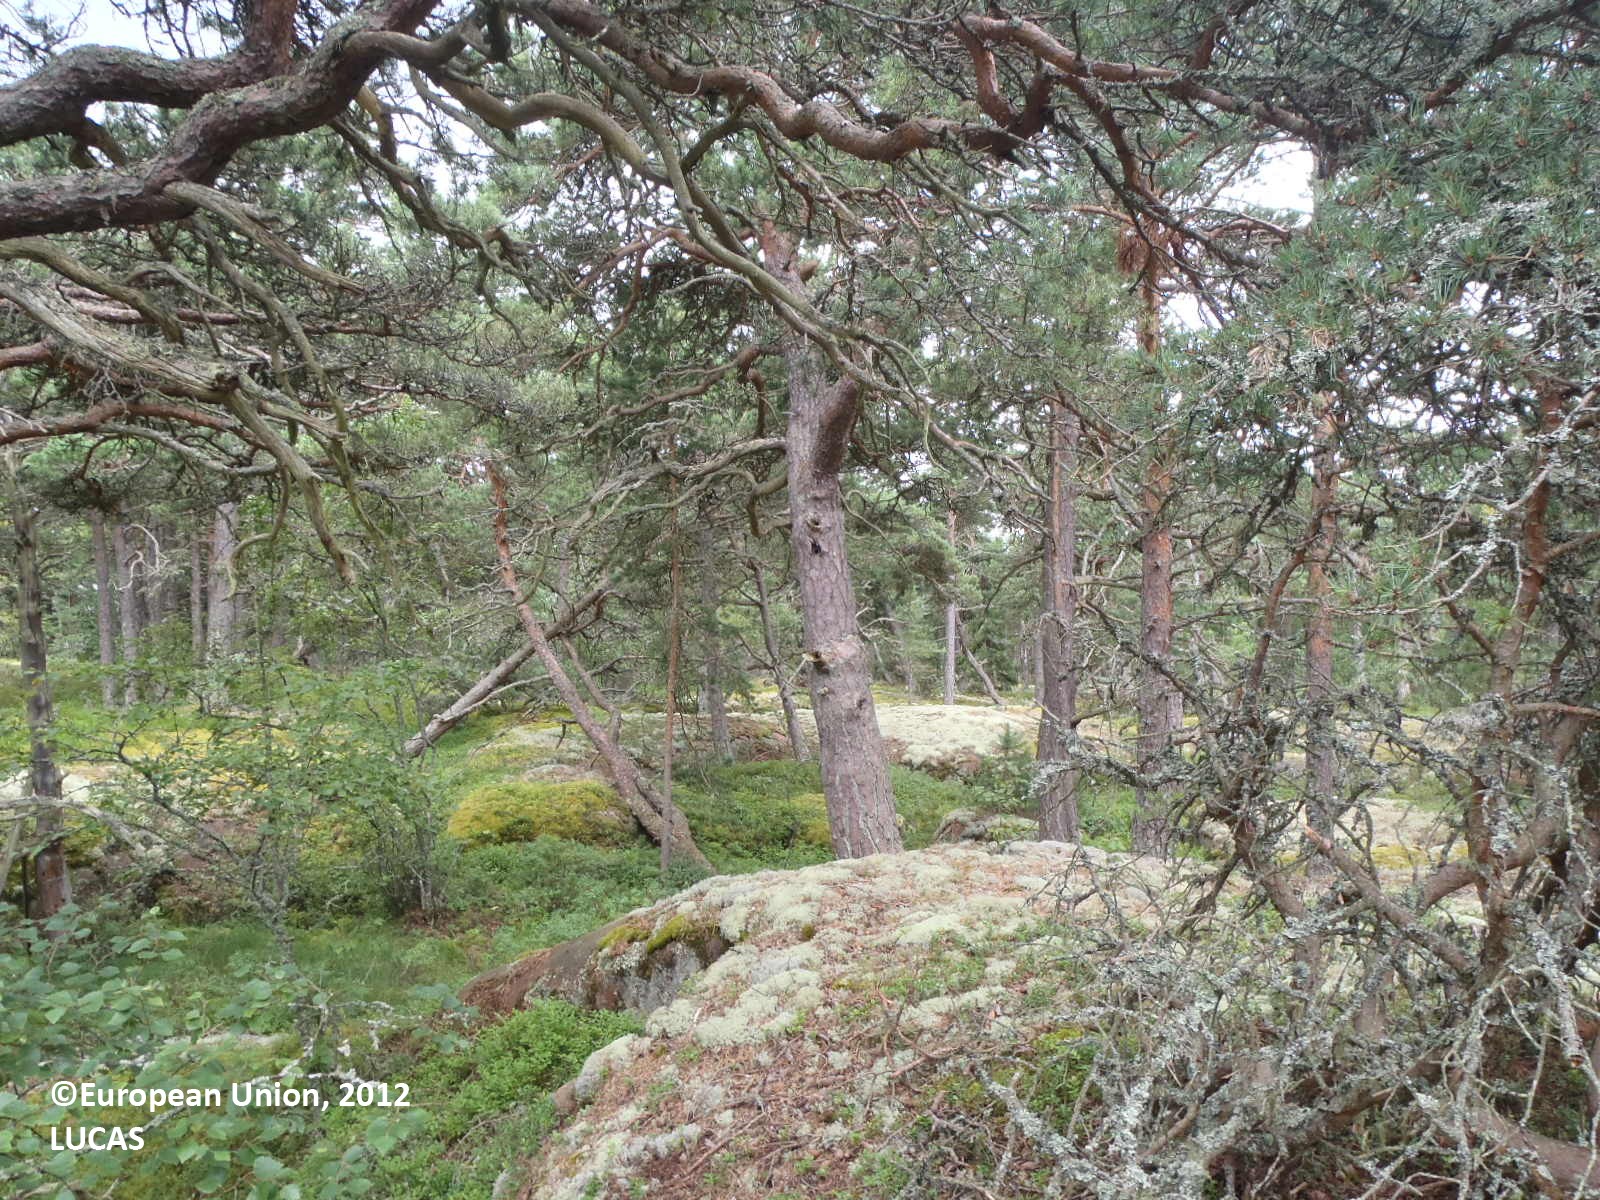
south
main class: Woodland
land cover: Pine dominated coniferous woodland
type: boreal forest
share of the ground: 50 - 75 %
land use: Semi-natural and natural areas not in use
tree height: > 5 m
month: August
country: FI
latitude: 59.9911
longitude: 20.2095
